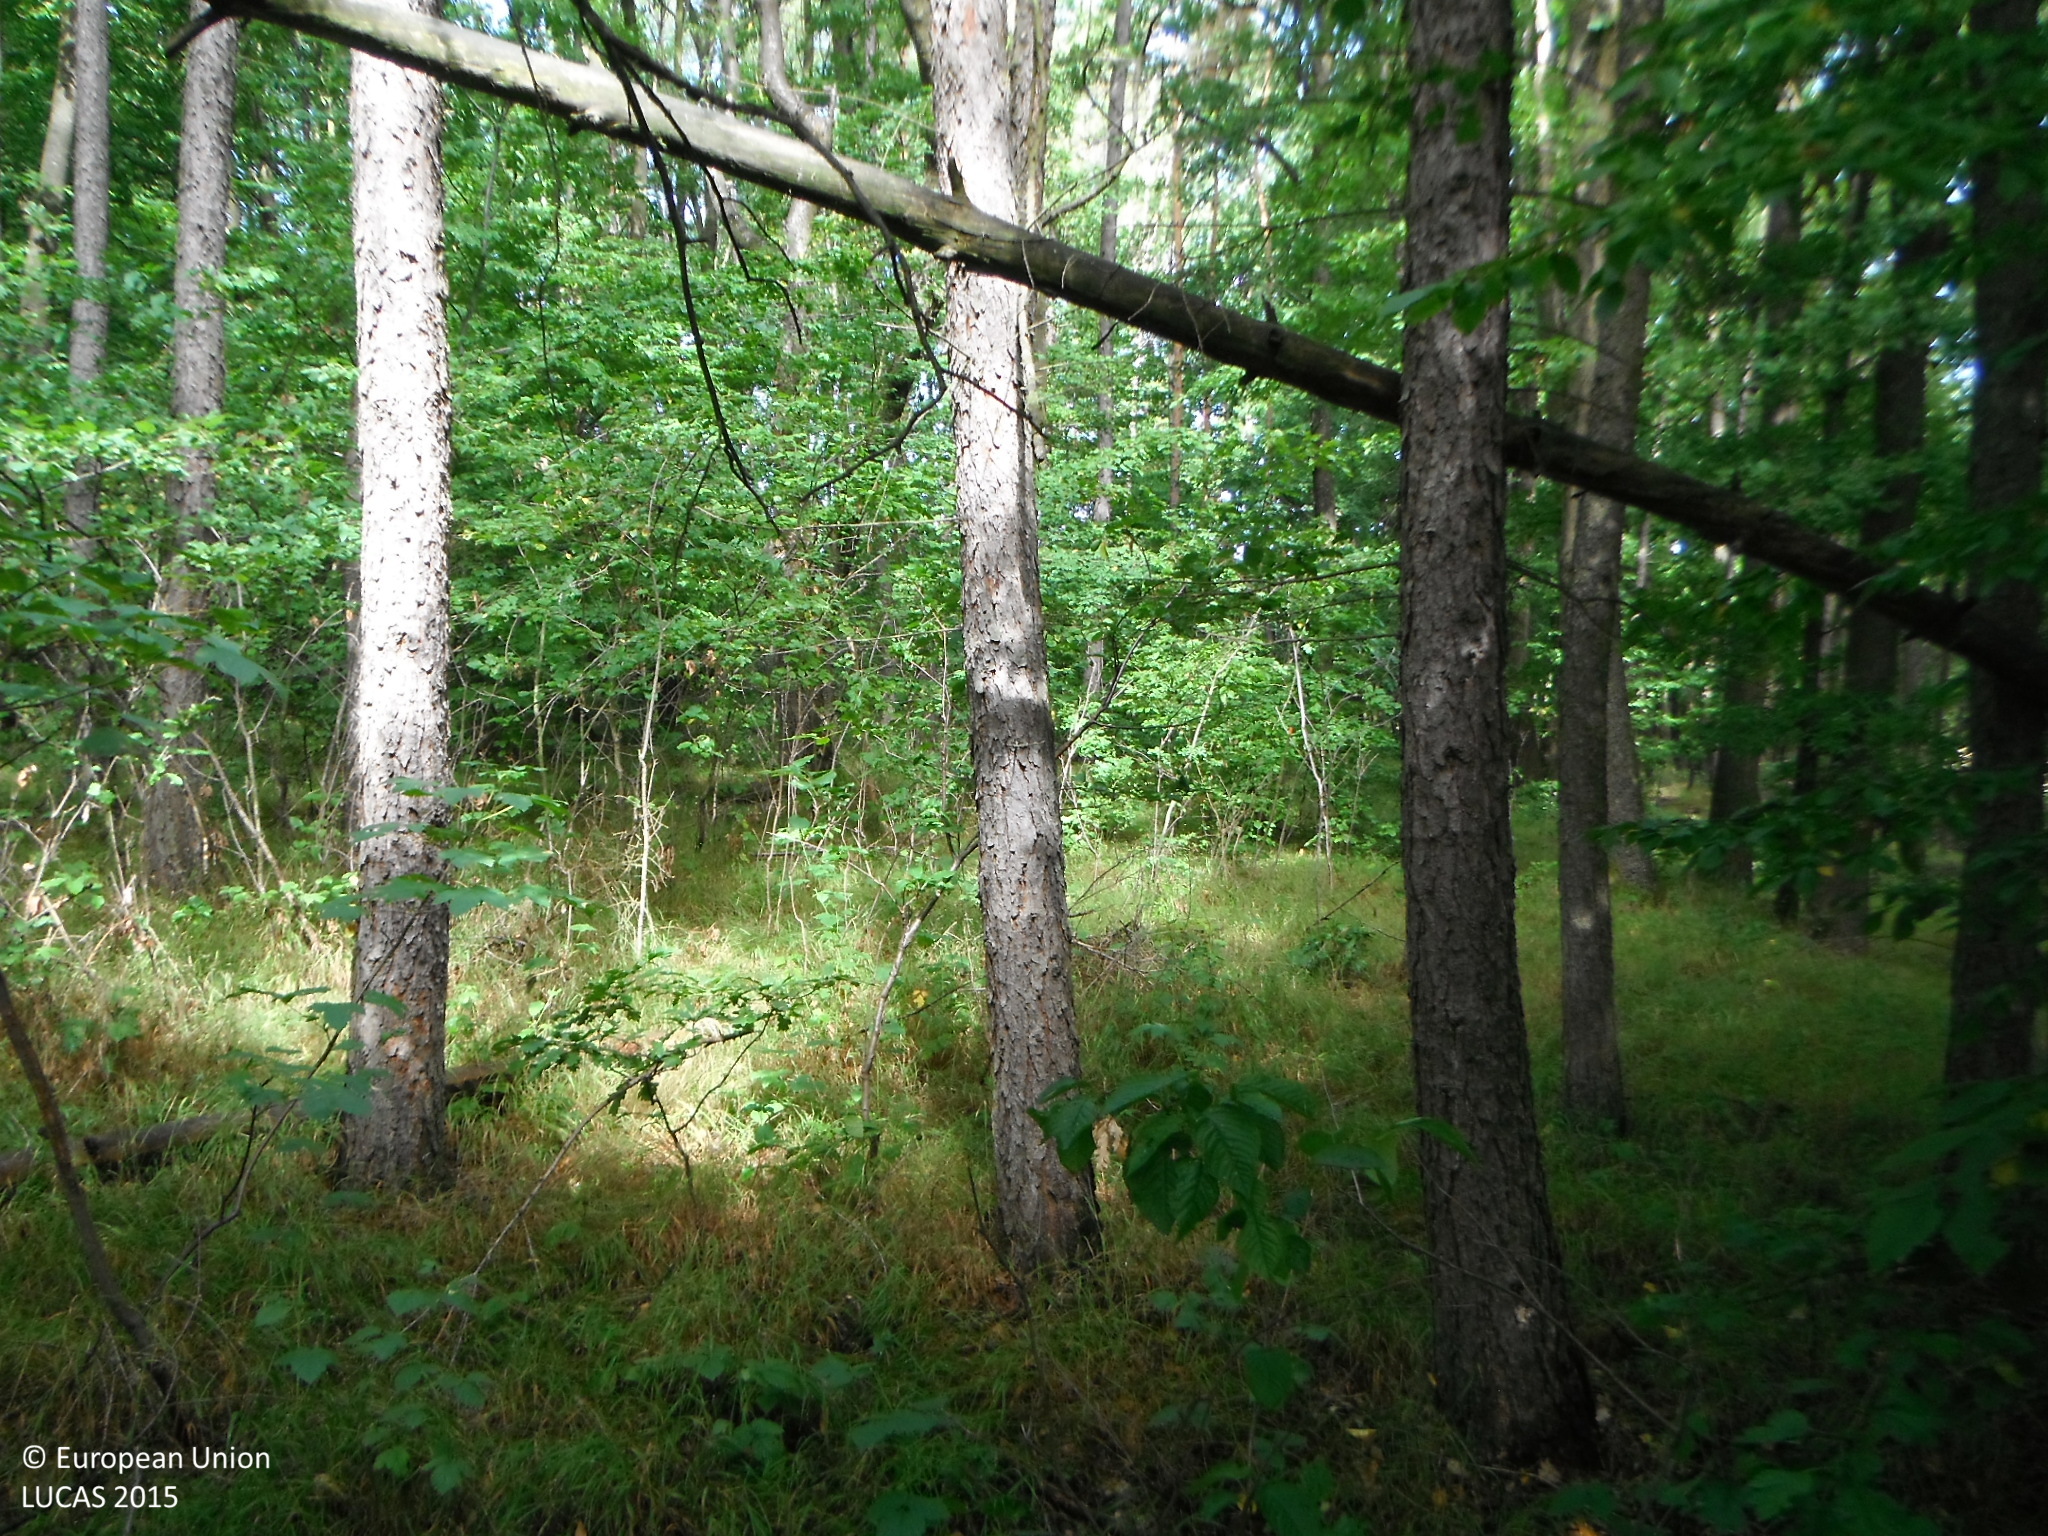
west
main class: Woodland
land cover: Other mixed woodland
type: hemiboreal forest and nemoral coniferous forest and mixed broadleaved-coniferous forest
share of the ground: > 75 %
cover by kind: coniferous forest trees 60 %, broadleaved forest trees 40 %
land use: Forestry
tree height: > 5 m
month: July
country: SK
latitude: 48.7582
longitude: 18.3276
